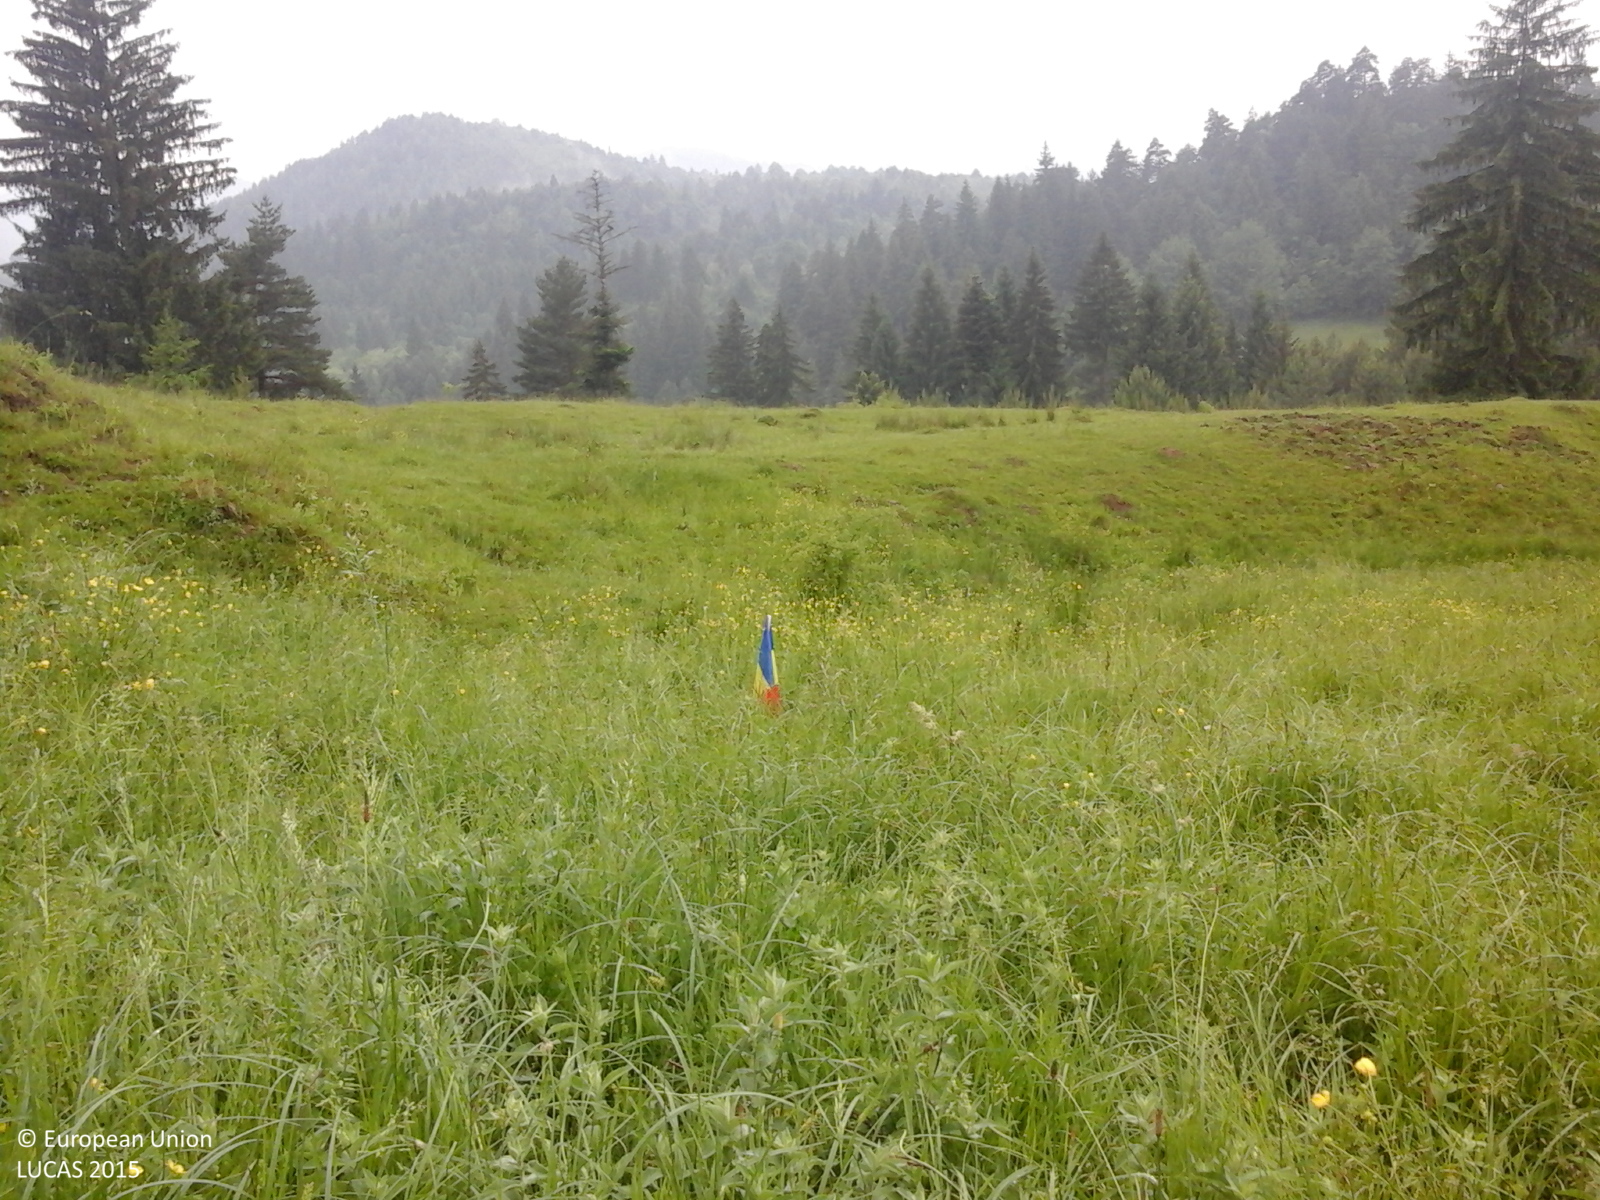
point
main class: Grassland
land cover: Grassland without tree/shrub cover
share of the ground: > 75 %
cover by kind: herbaceous plants 100 %
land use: Agriculture (excluding fallow land and kitchen gardens)
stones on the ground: < 10 %
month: June
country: RO
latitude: 46.4100
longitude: 26.4316
